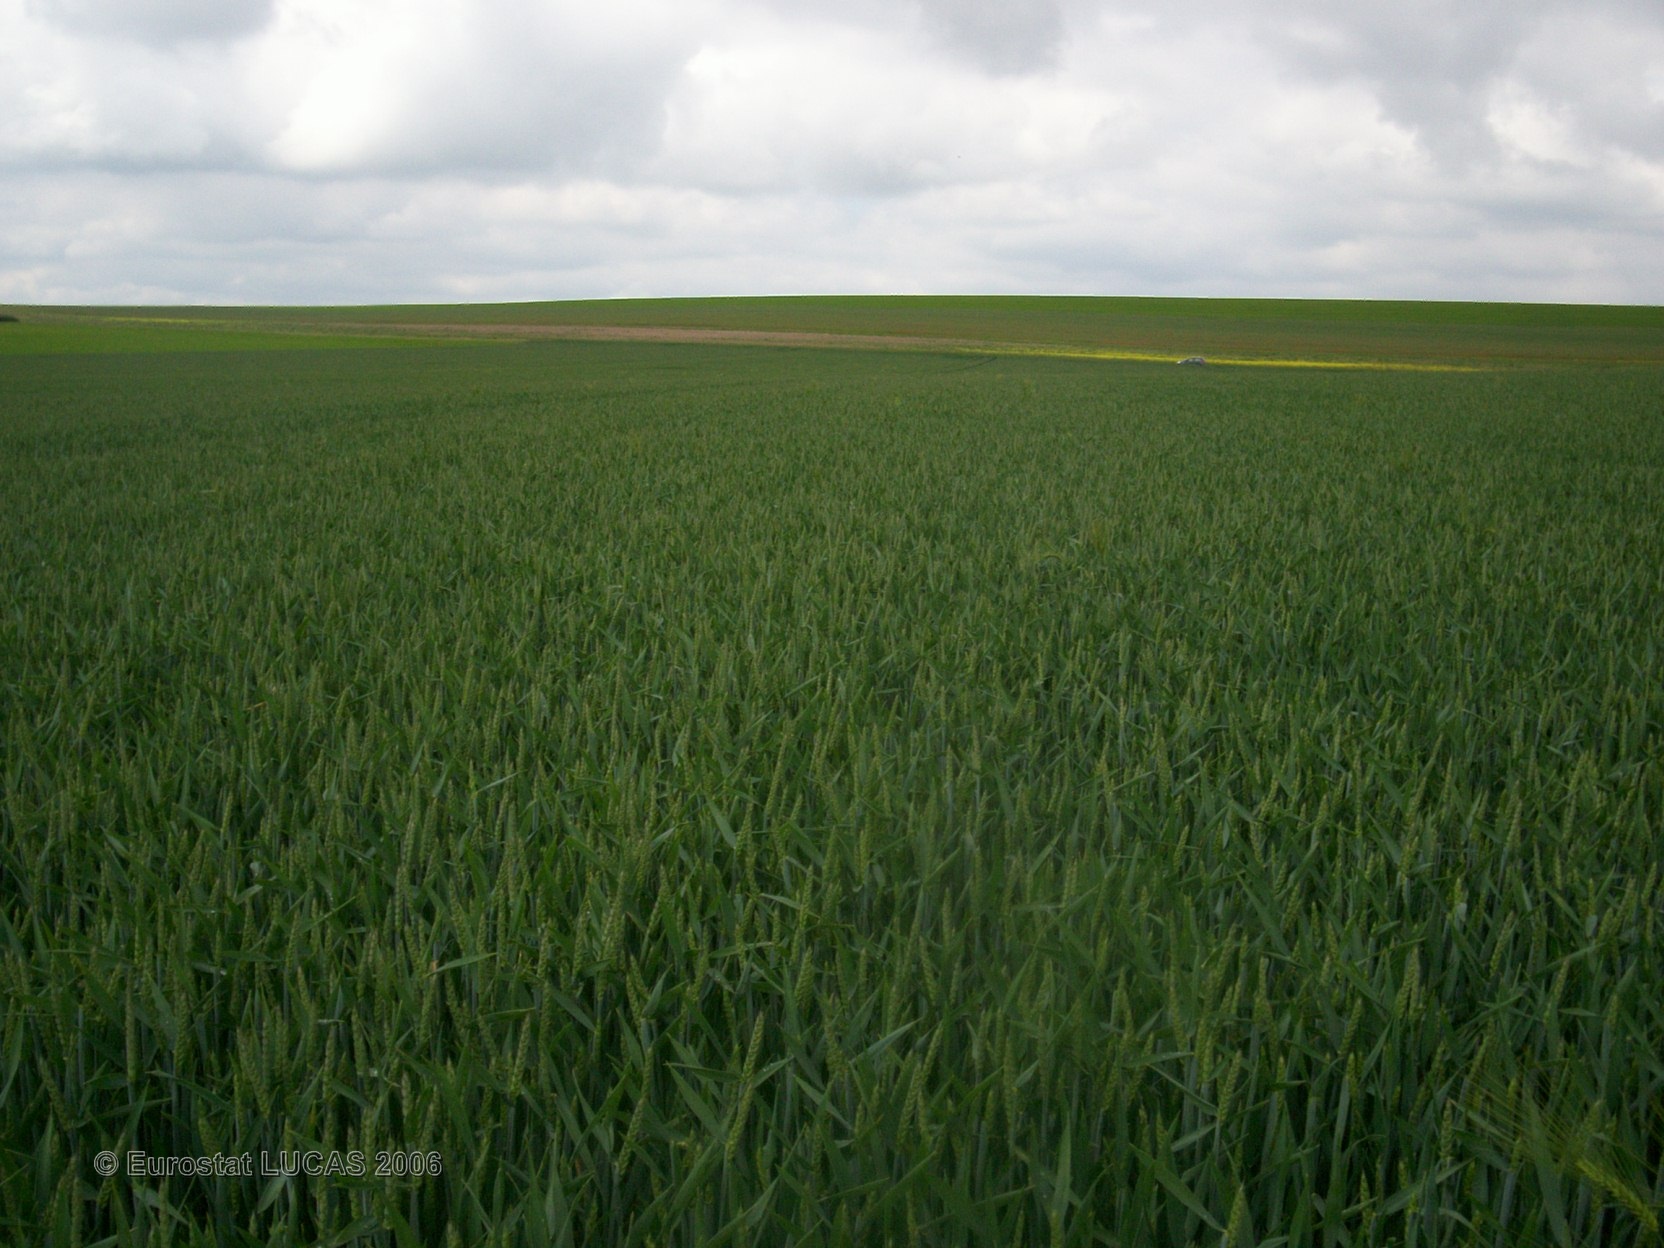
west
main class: Cropland
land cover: Common wheat
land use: Agriculture (excluding fallow land and kitchen gardens)
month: June
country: FR
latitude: 48.5902
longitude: 4.4790
